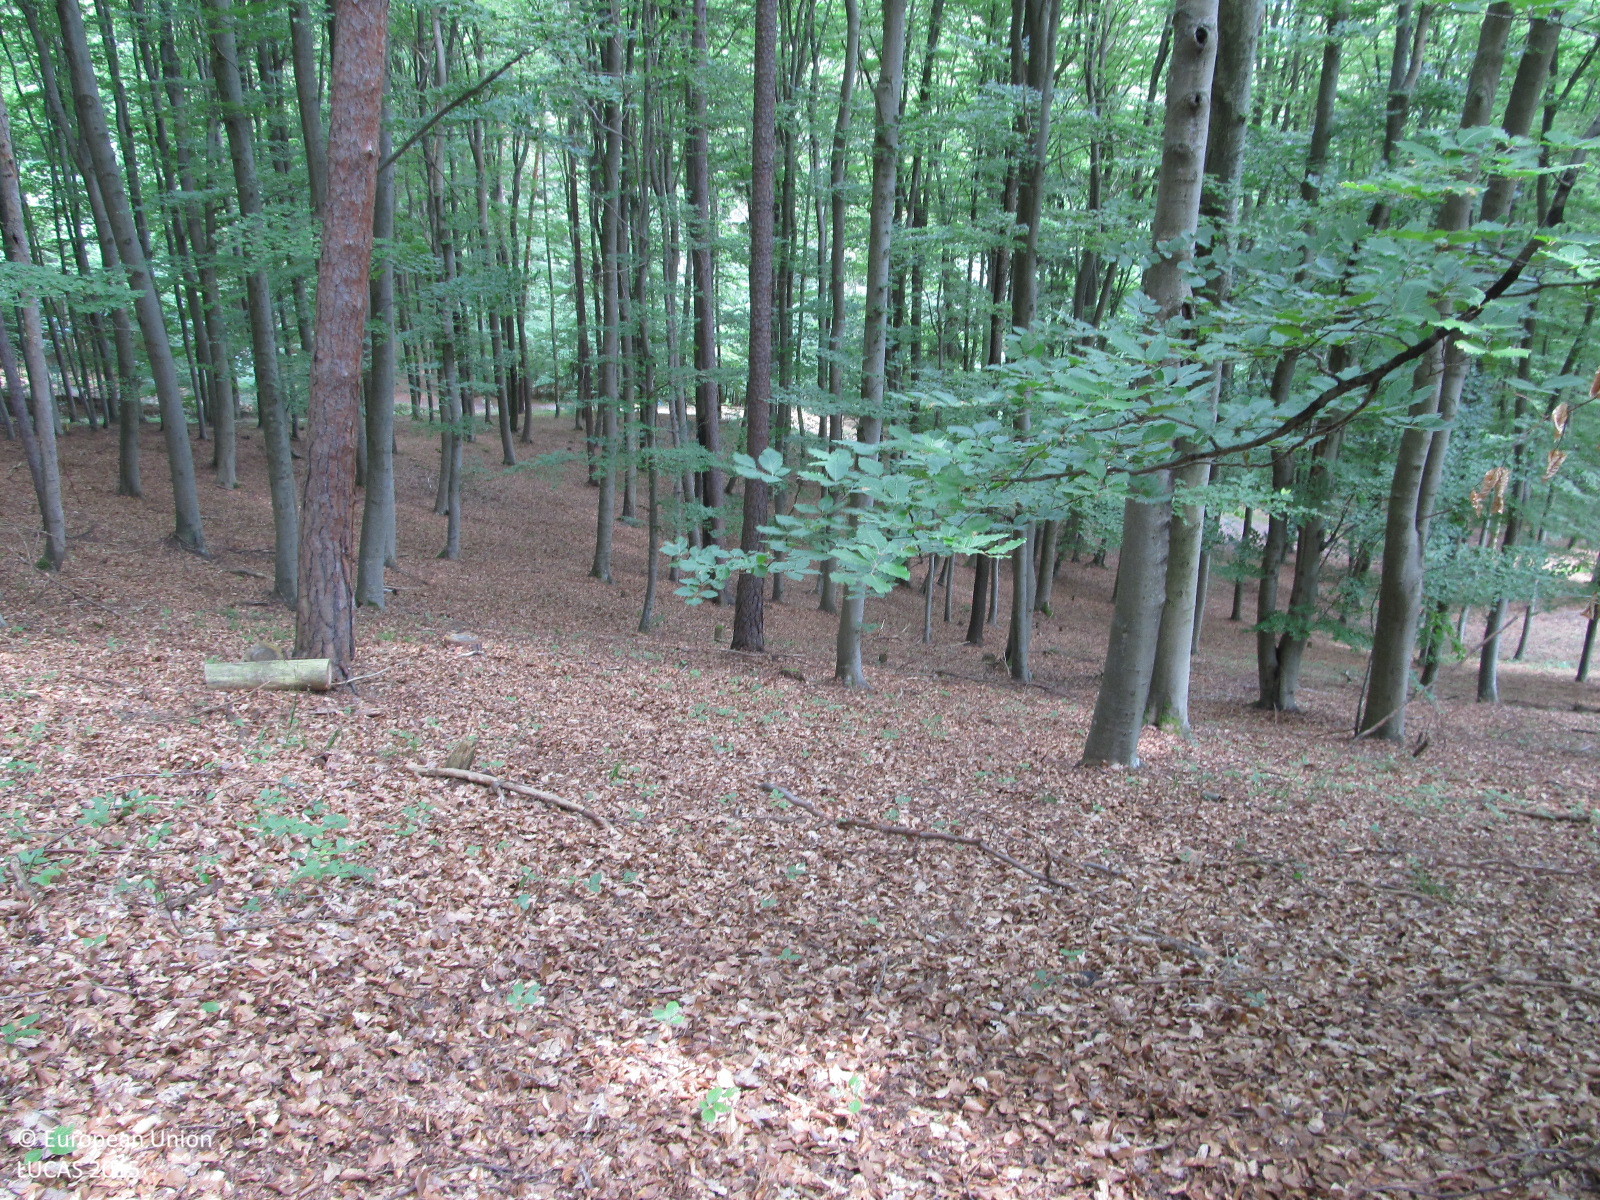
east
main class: Woodland
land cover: Broadleaved woodland
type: beech forest
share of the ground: > 75 %
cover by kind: broadleaved forest trees 60 %, coniferous forest trees 20 %, unconsolidated bare surface 20 %
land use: Forestry
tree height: > 5 m
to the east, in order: Broadleaved woodland; Tracks; Broadleaved woodland; Tracks; Broadleaved woodland; Spruce dominated coniferous woodland; Broadleaved woodland
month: June
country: AT
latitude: 48.4135
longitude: 15.4473
